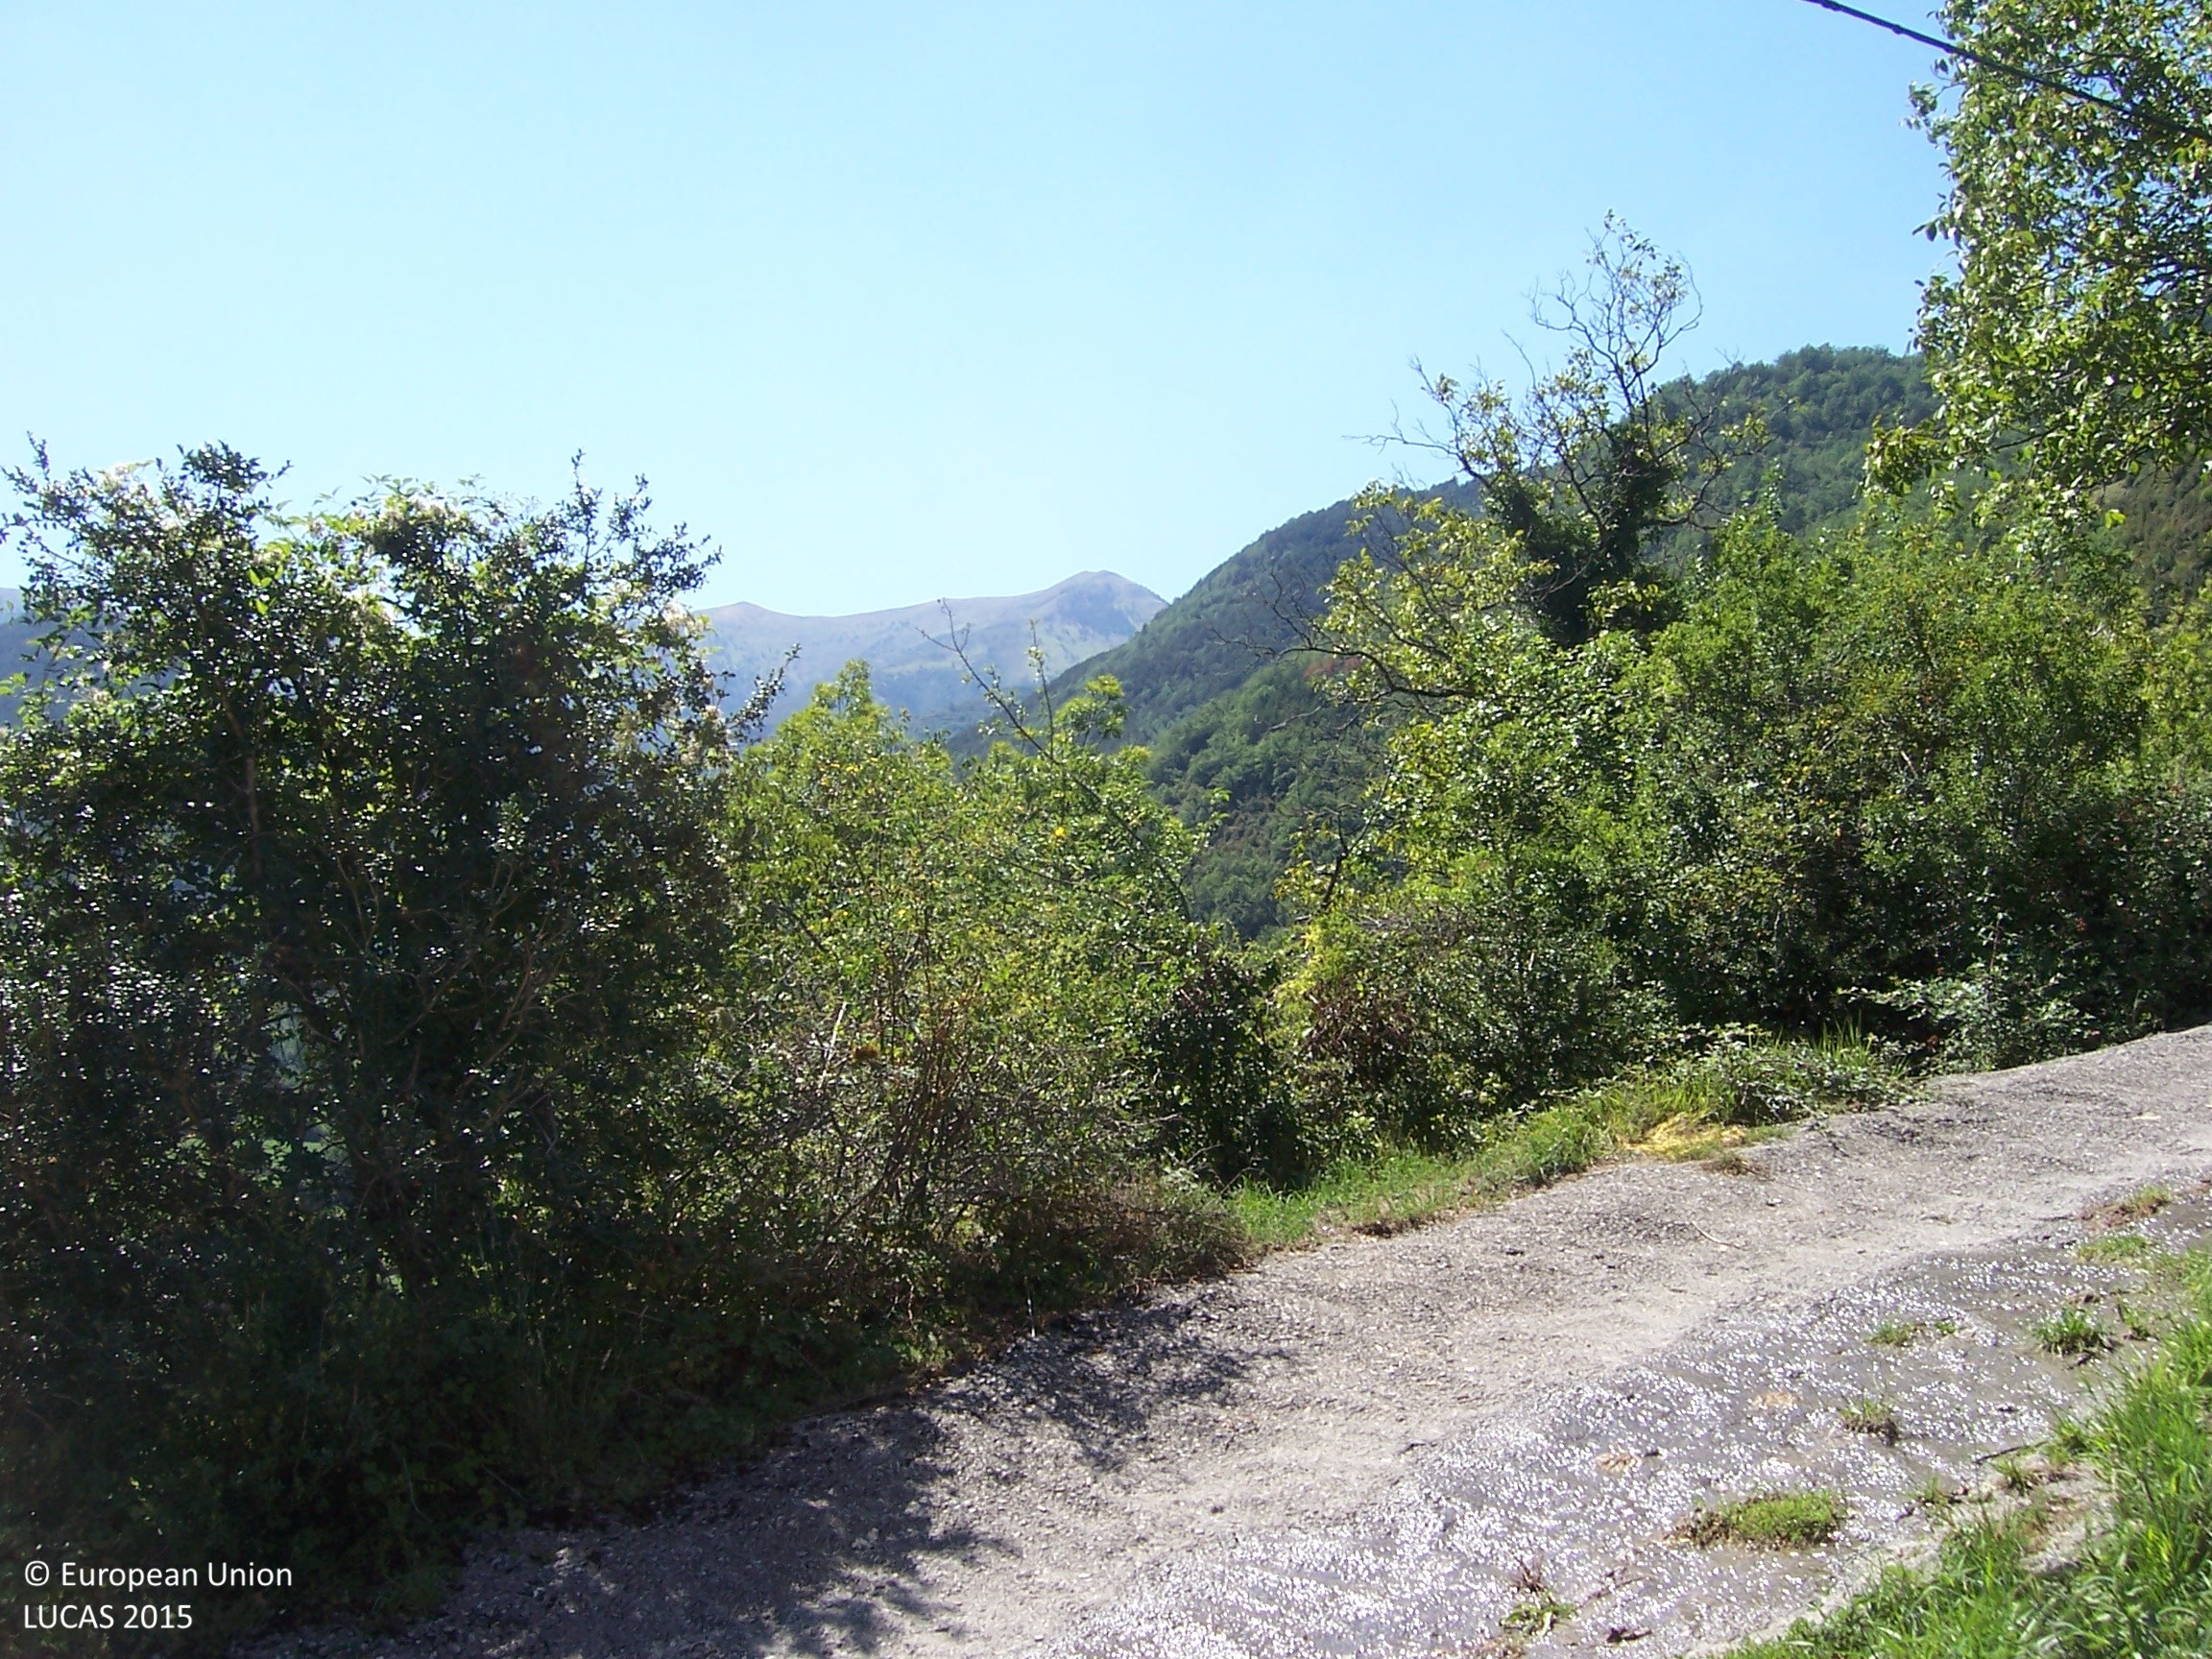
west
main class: Grassland
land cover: Grassland with sparse tree/shrub cover
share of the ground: > 75 %
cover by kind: herbaceous plants 95 %, broadleaved forest trees 5 %
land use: Semi-natural and natural areas not in use
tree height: > 5 m
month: August
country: ES
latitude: 42.5997
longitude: -0.1281
